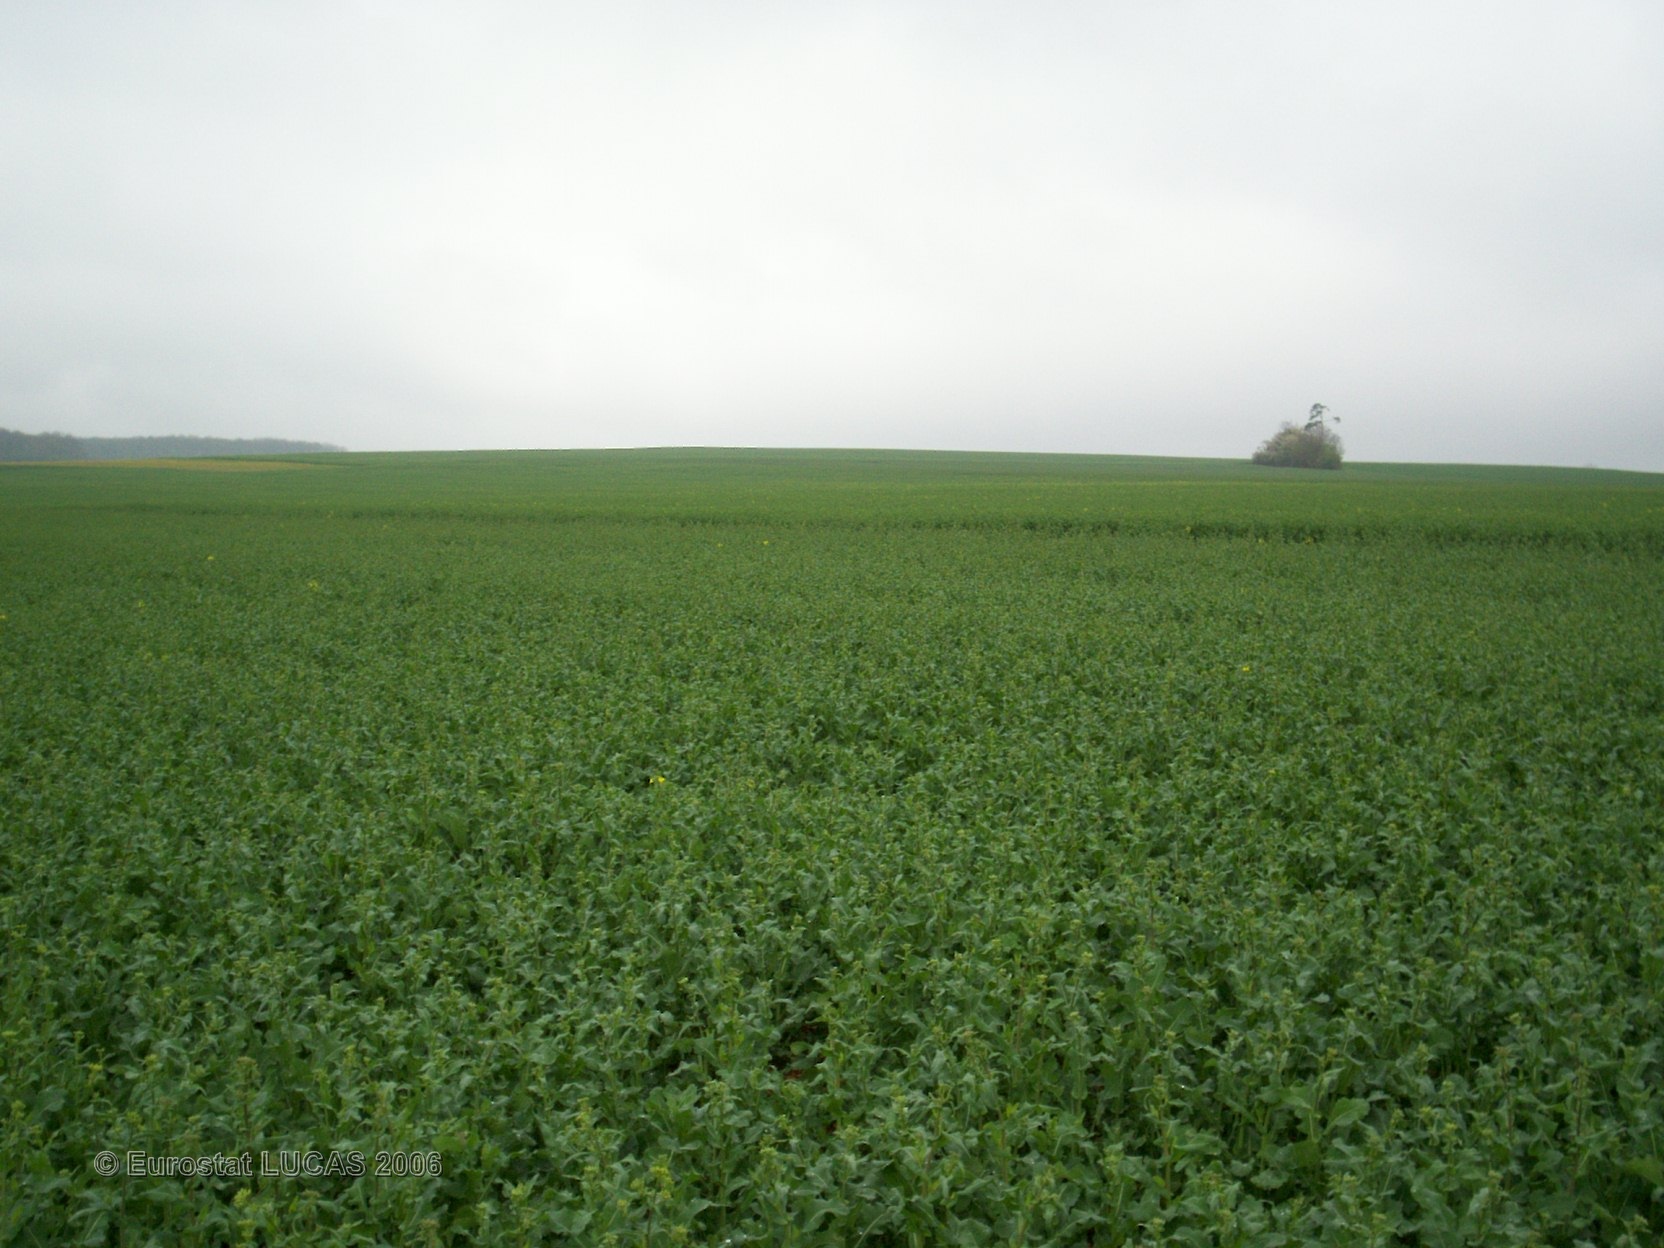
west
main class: Cropland
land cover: Rape and turnip rape
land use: Agriculture (excluding fallow land and kitchen gardens)
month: April
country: FR
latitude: 47.7983
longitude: 4.5113
